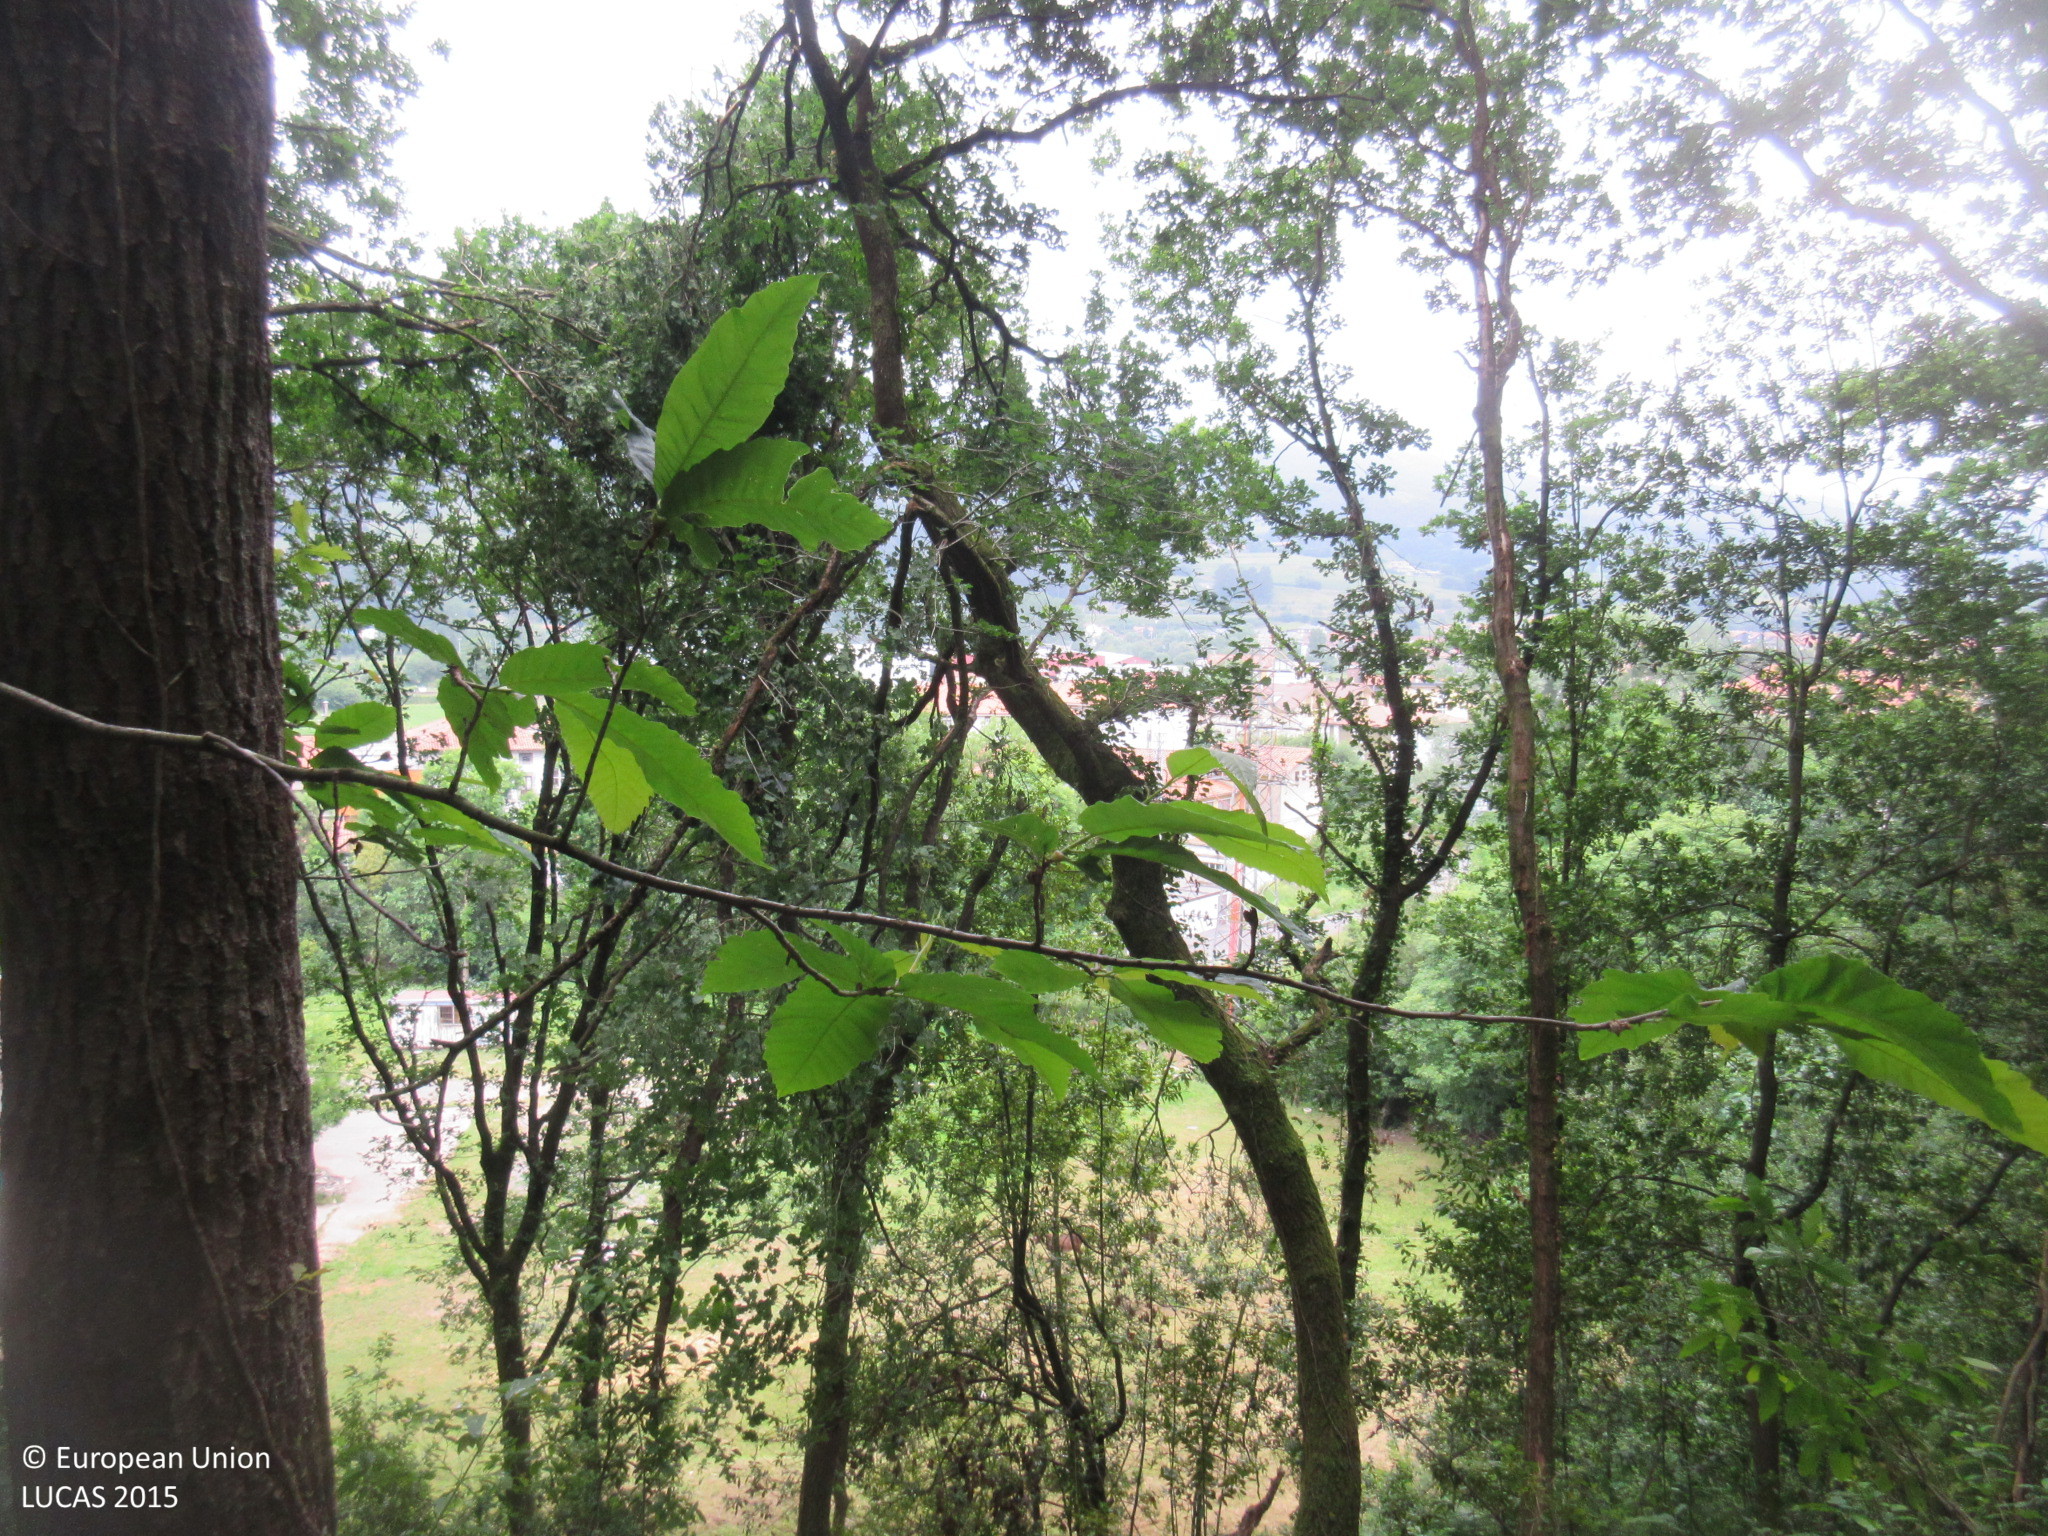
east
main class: Woodland
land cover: Broadleaved woodland
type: thermophilous deciduous forest
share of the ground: > 75 %
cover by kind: broadleaved forest trees 95 %, shrubs 5 %
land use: Forestry
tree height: > 5 m
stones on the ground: < 10 %
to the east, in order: Broadleaved woodland; Electric lines; Shrubland with sparse tree cover; Tracks; Abandoned hedges; Grassland without tree/shrub cover; Artificial constructions in urban areas; Broadleaved woodland
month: June
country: ES
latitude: 43.3456
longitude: -3.4267
